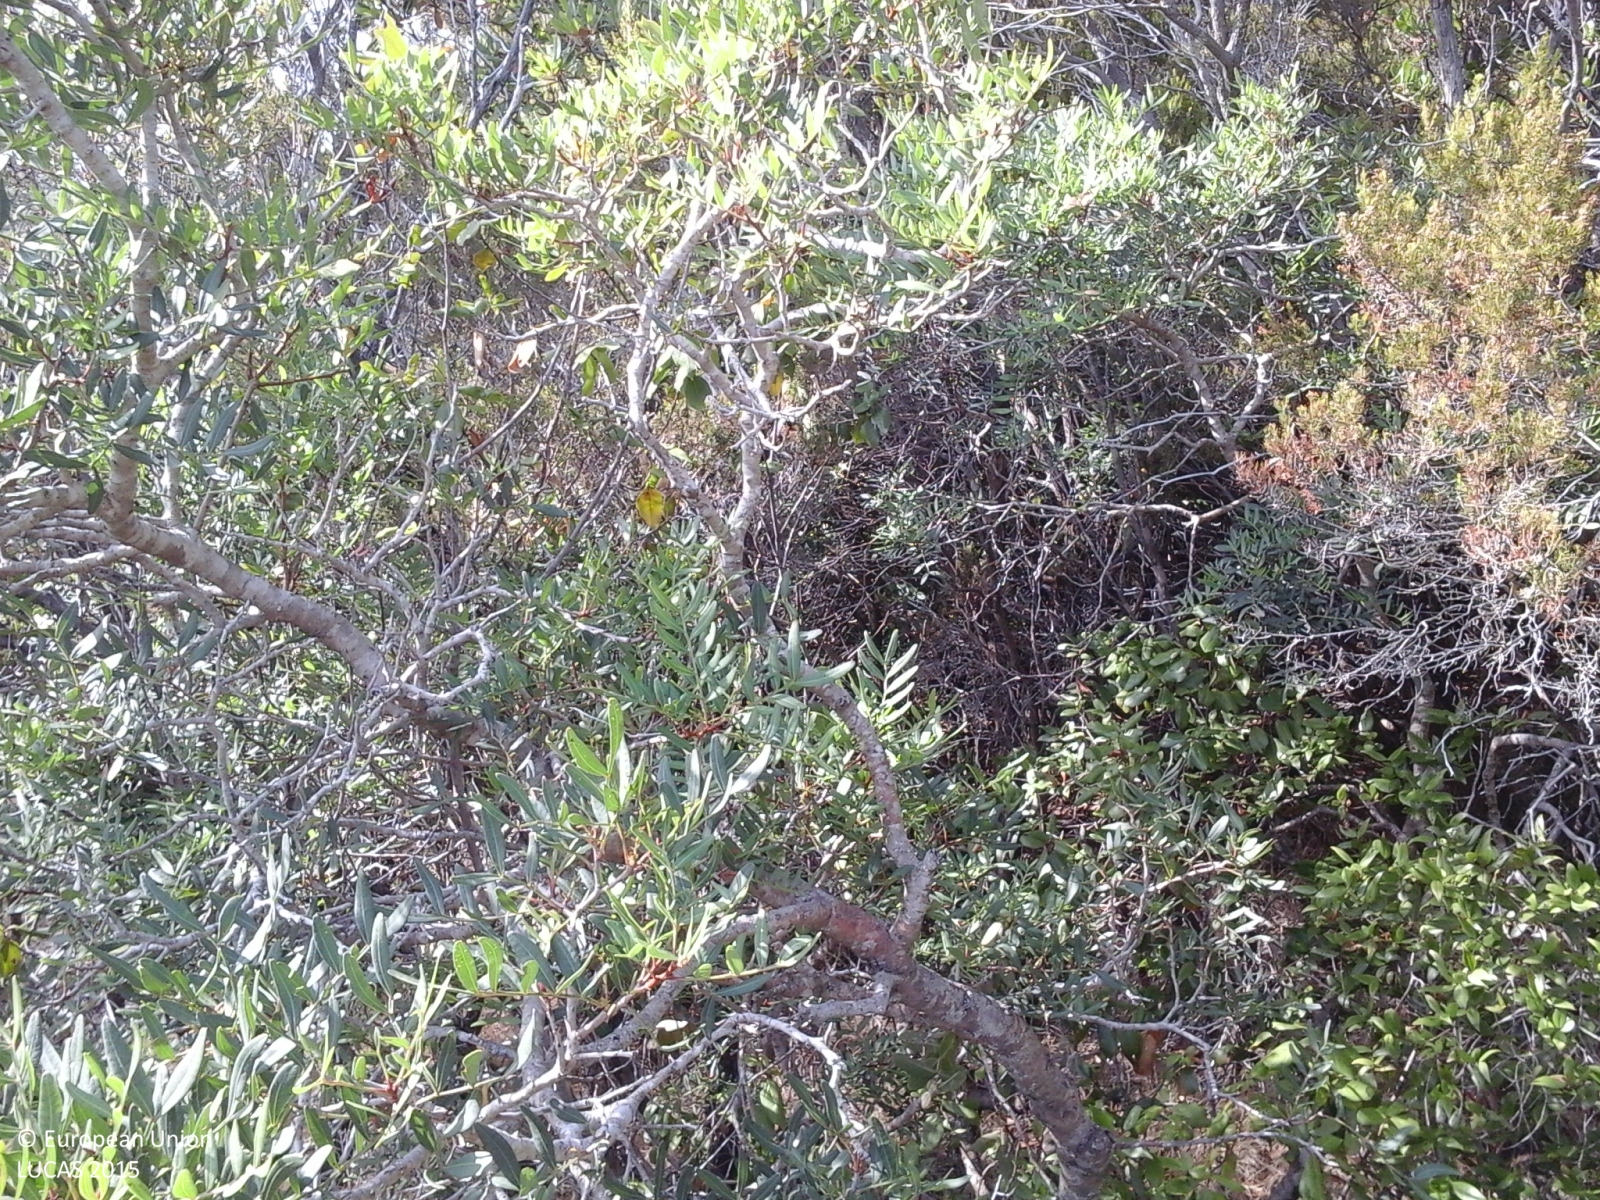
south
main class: Woodland
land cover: Other mixed woodland
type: broadleaved evergreen forest
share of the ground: > 75 %
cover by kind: broadleaved forest trees 75 %, coniferous forest trees 25 %
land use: Semi-natural and natural areas not in use
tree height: < 5 m
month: July
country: IT
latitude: 42.7982
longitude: 10.2559
